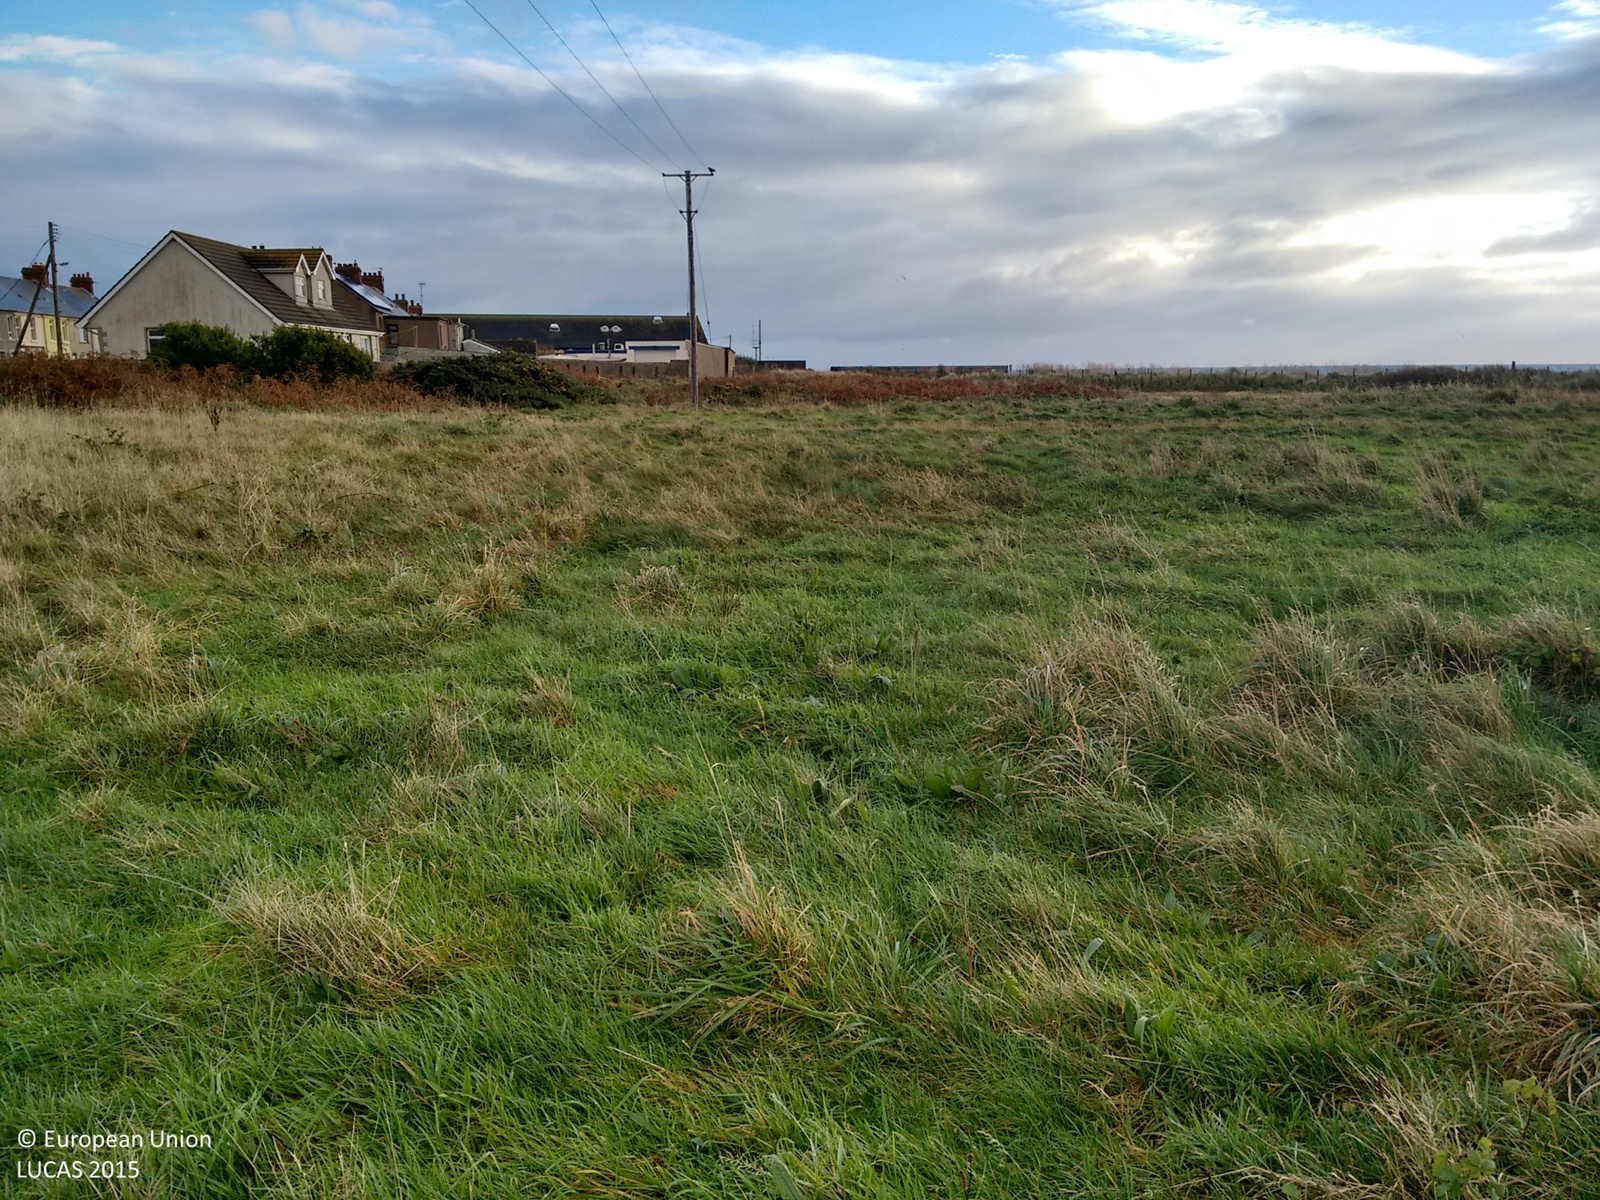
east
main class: Grassland
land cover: Grassland without tree/shrub cover
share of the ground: > 75 %
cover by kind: herbaceous plants 100 %
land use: Agriculture (excluding fallow land and kitchen gardens)
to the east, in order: Grassland without tree/shrub cover; Tracks; Grassland without tree/shrub cover; Tracks; Grassland without tree/shrub cover; Electric lines; Grassland without tree/shrub cover; Artificial constructions in urban areas; Grassland without tree/shrub cover
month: November
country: GB
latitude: 54.4558
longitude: -5.4428
